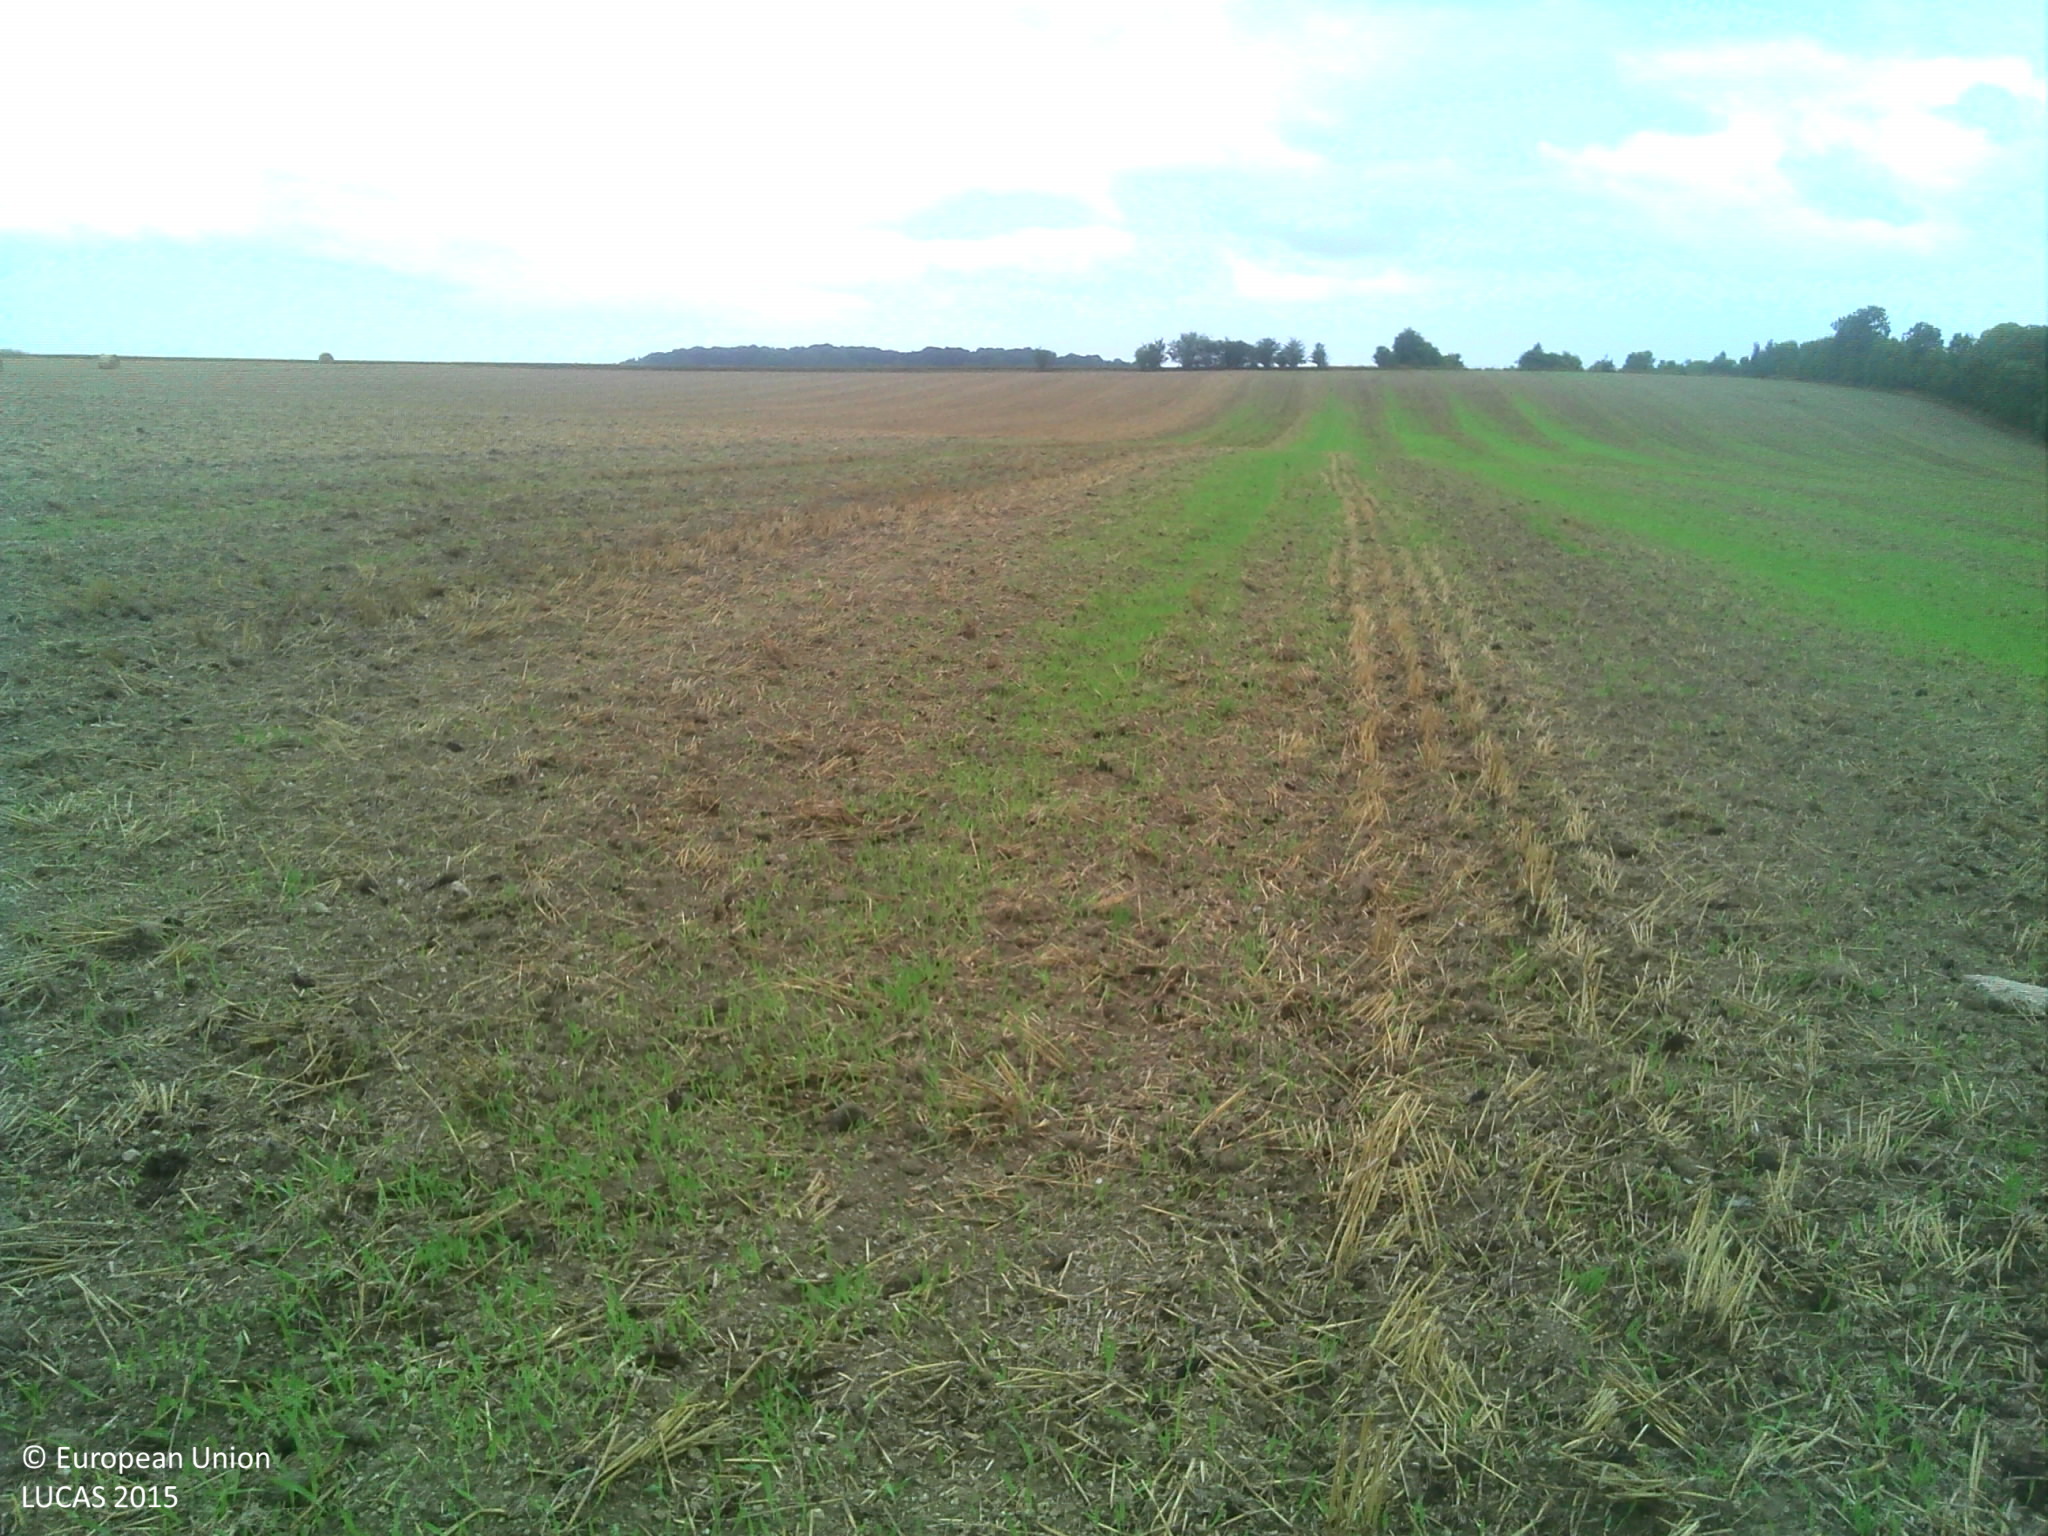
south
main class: Cropland
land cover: Barley
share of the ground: 25 - 50 %
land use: Agriculture (excluding fallow land and kitchen gardens)
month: July
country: FR
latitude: 49.9127
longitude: 3.5730
